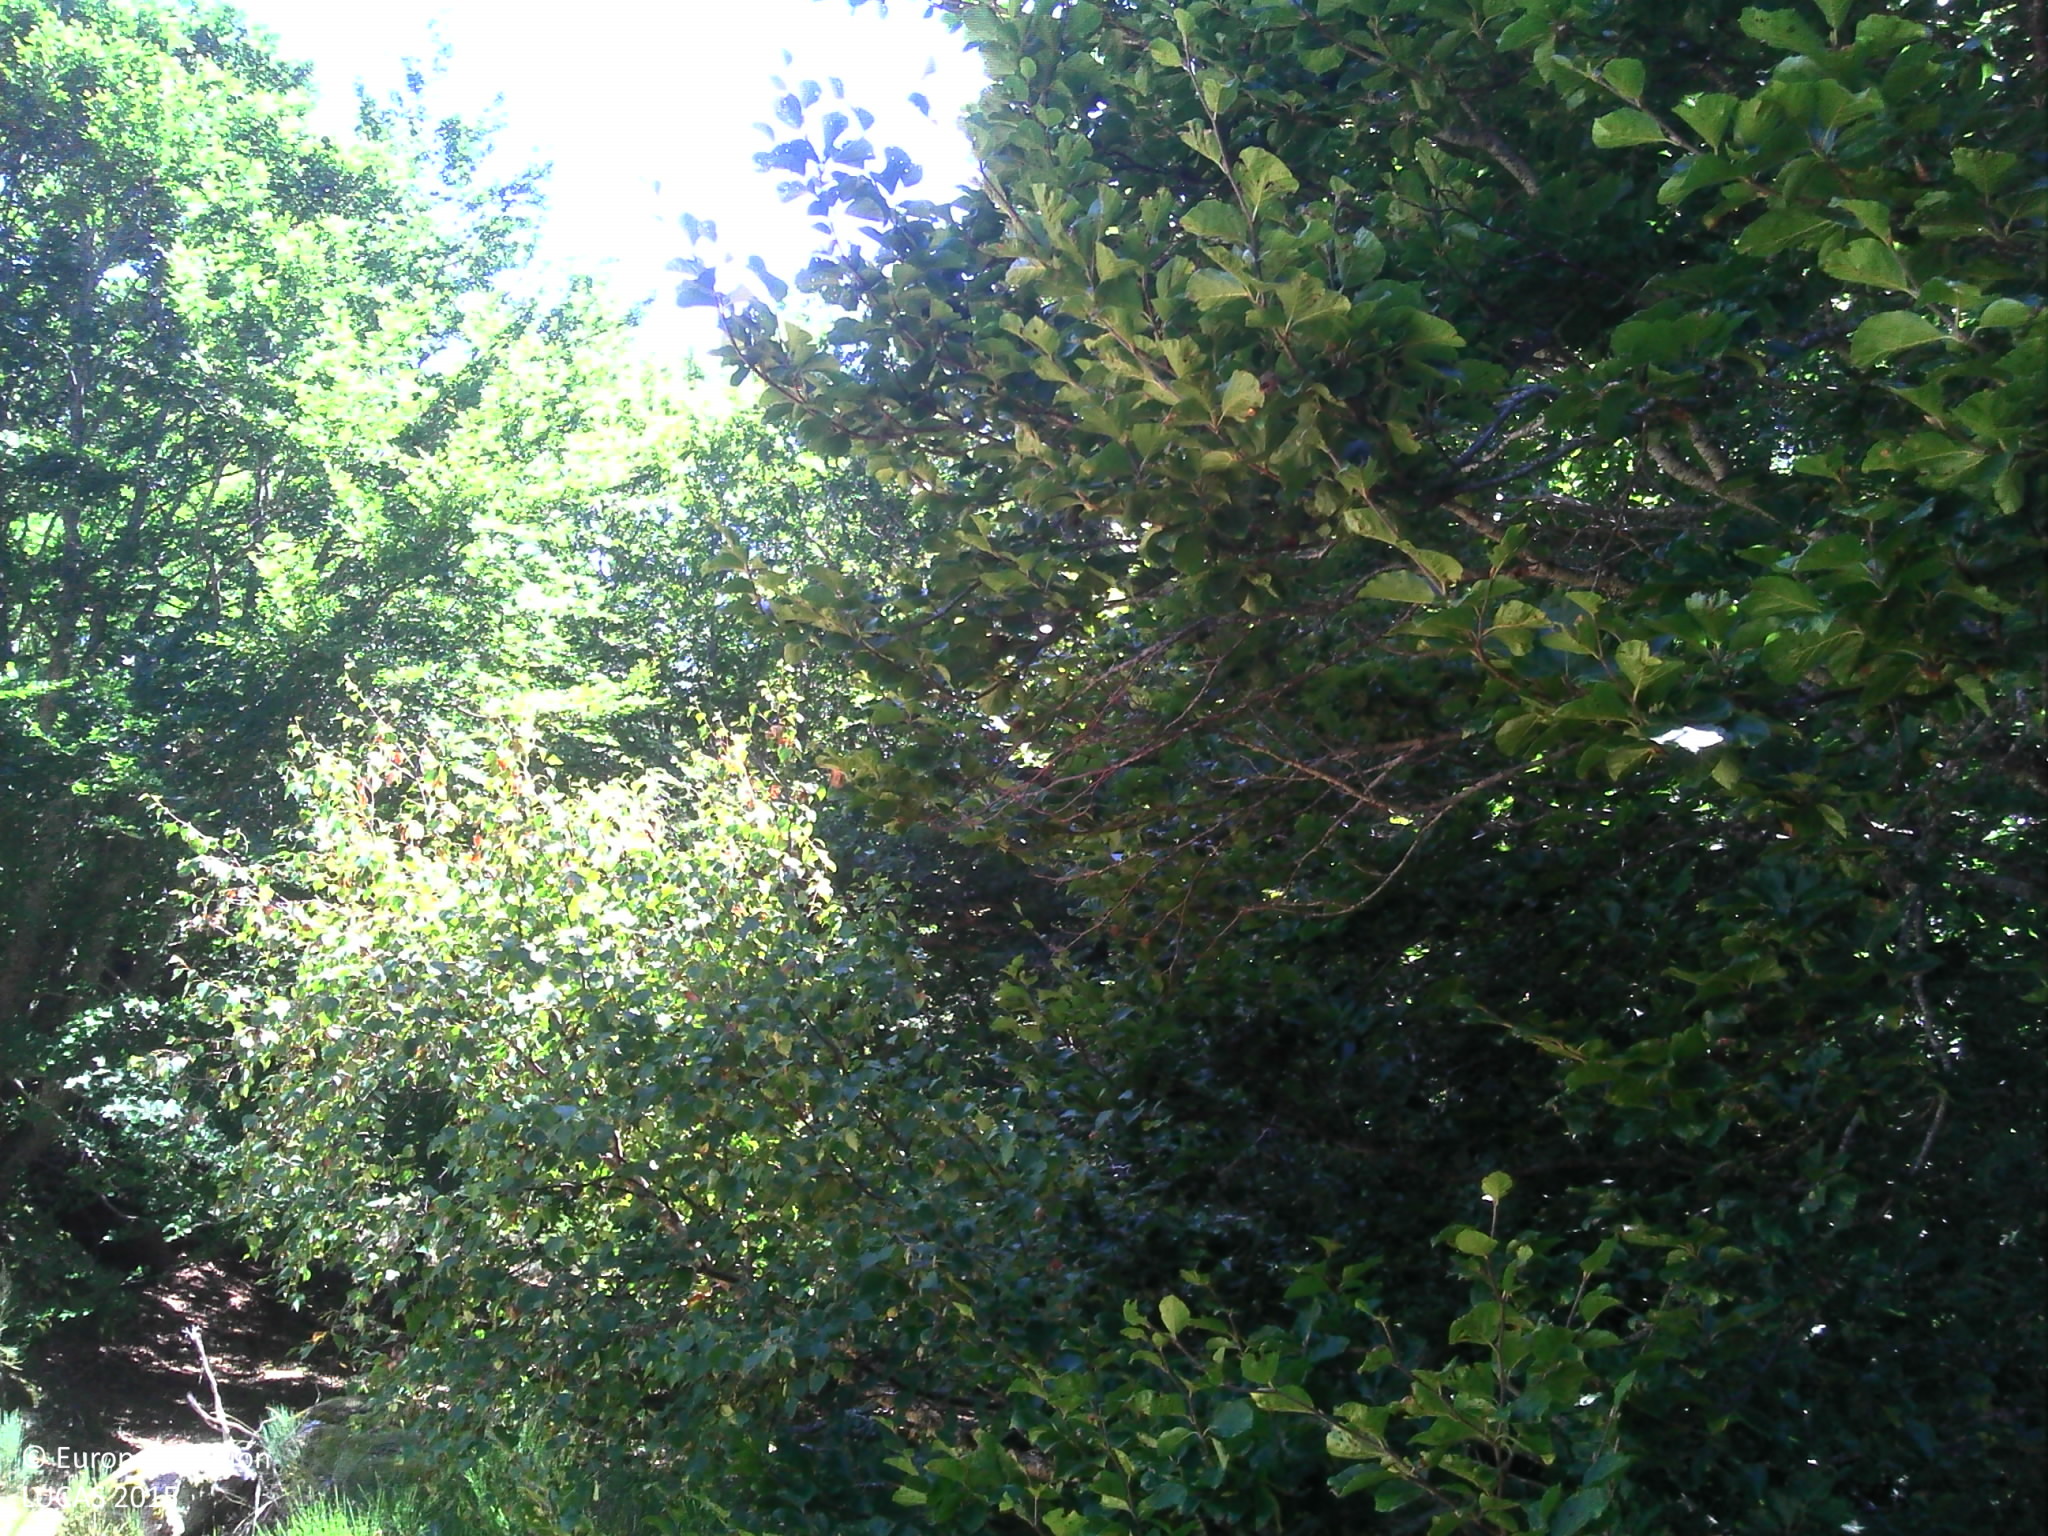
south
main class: Grassland
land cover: Grassland without tree/shrub cover
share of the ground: > 75 %
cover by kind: herbaceous plants 95 %, shrubs 5 %
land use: Agriculture (excluding fallow land and kitchen gardens)
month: July
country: FR
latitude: 44.7045
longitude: 3.4540
